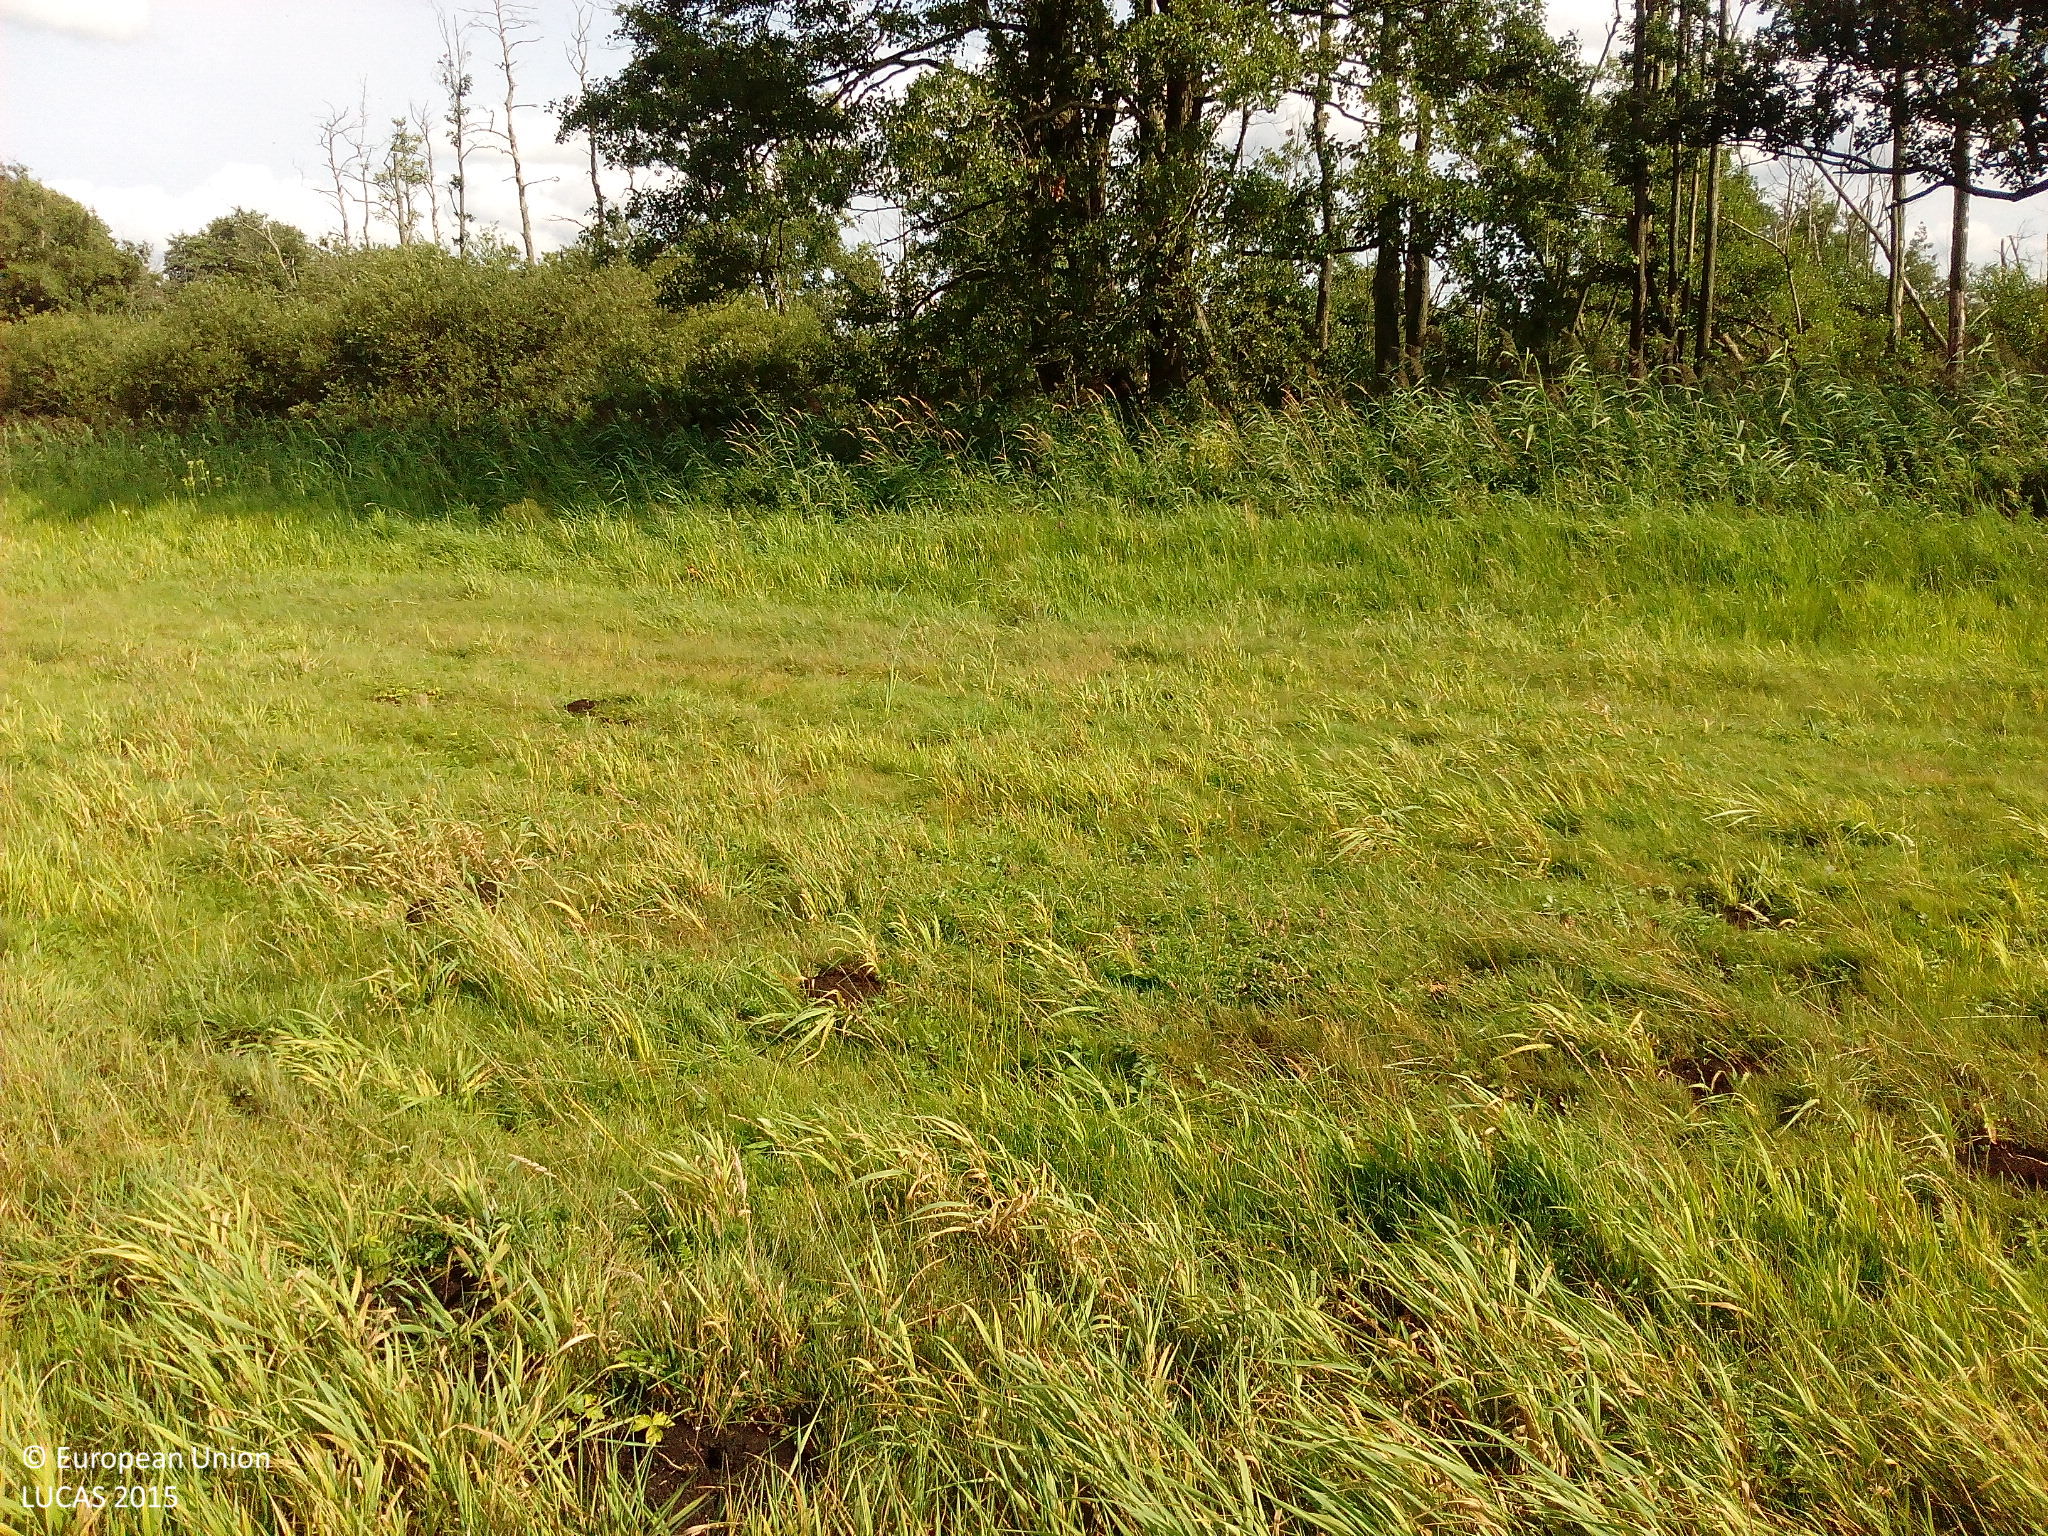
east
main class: Grassland
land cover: Grassland without tree/shrub cover
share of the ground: > 75 %
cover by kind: herbaceous plants 100 %
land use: Agriculture (excluding fallow land and kitchen gardens)
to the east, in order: Grassland without tree/shrub cover; Shruby margins; Ditches and canals; Broadleaved woodland; Ditches and canals; Inland marshes; Broadleaved woodland; Ditches and canals; Fences; Grassland without tree/shrub cover
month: August
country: DE
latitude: 53.9295
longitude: 12.6949
